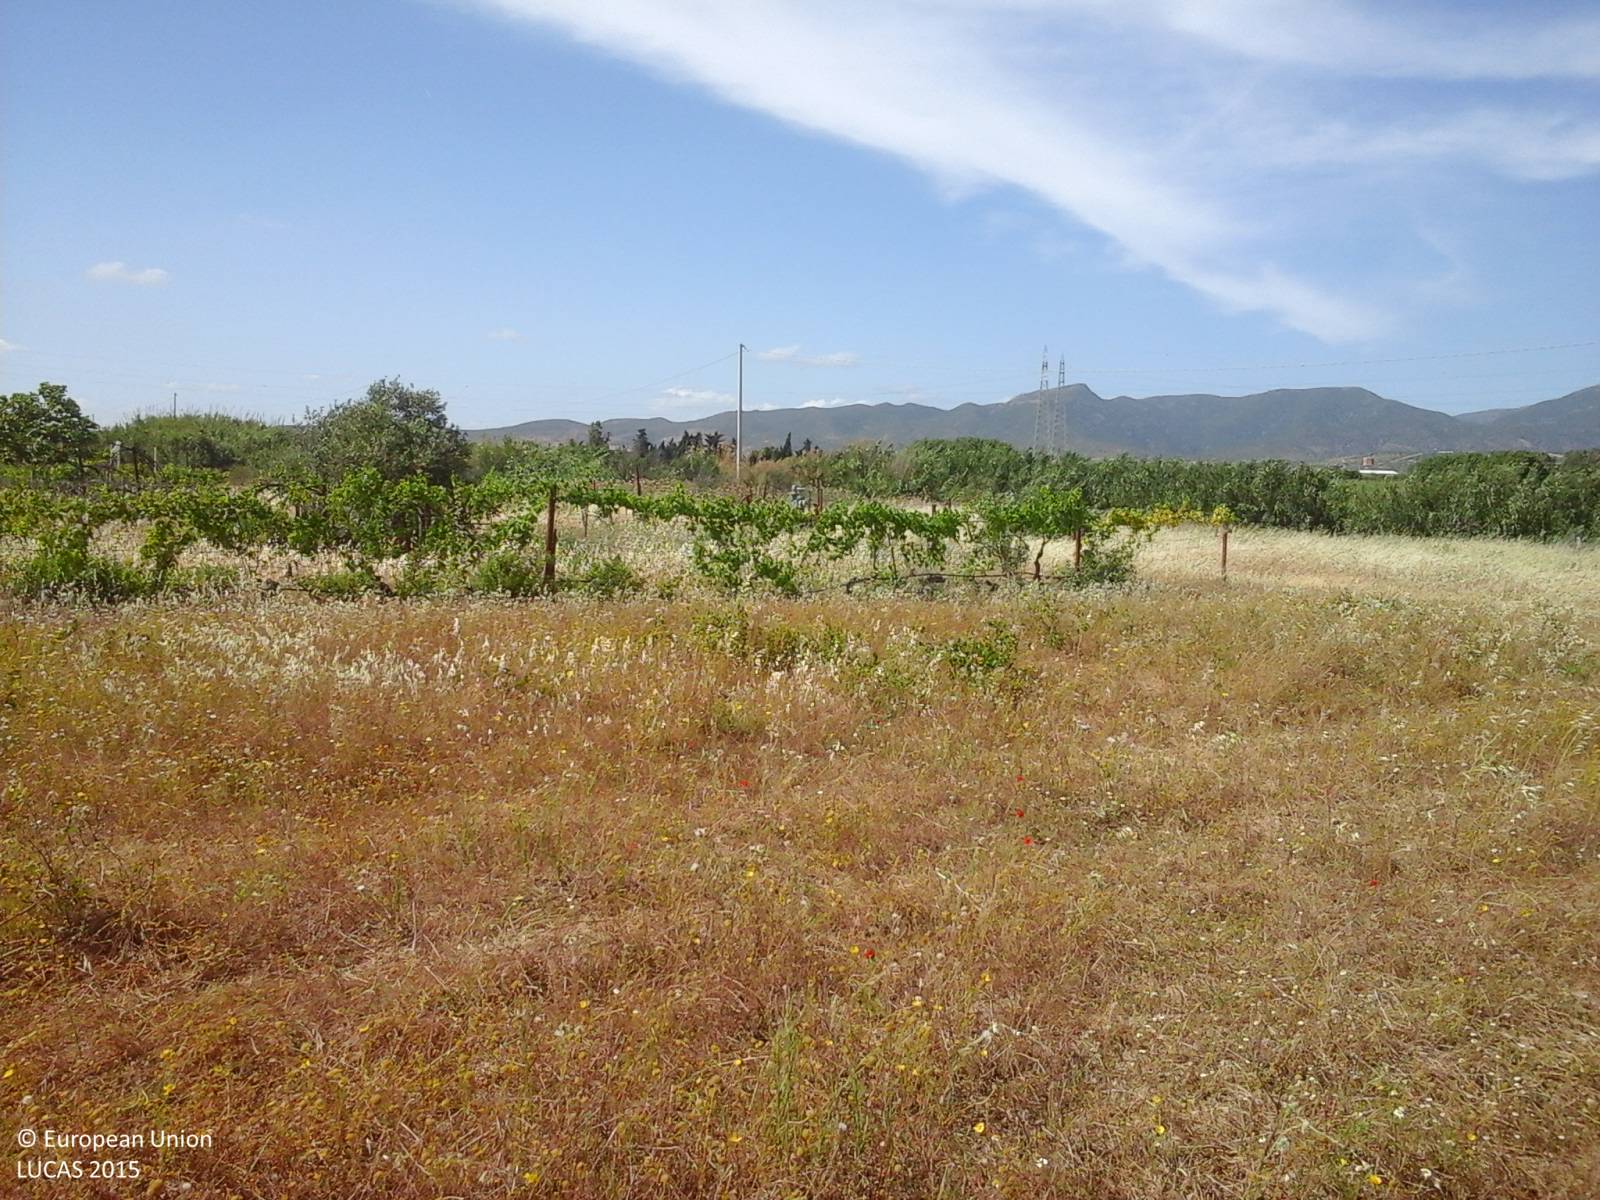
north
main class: Grassland
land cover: Spontaneously vegetated surfaces
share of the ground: > 75 %
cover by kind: herbaceous plants 100 %
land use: Fallow land
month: May
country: IT
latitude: 39.2681
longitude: 9.2282
